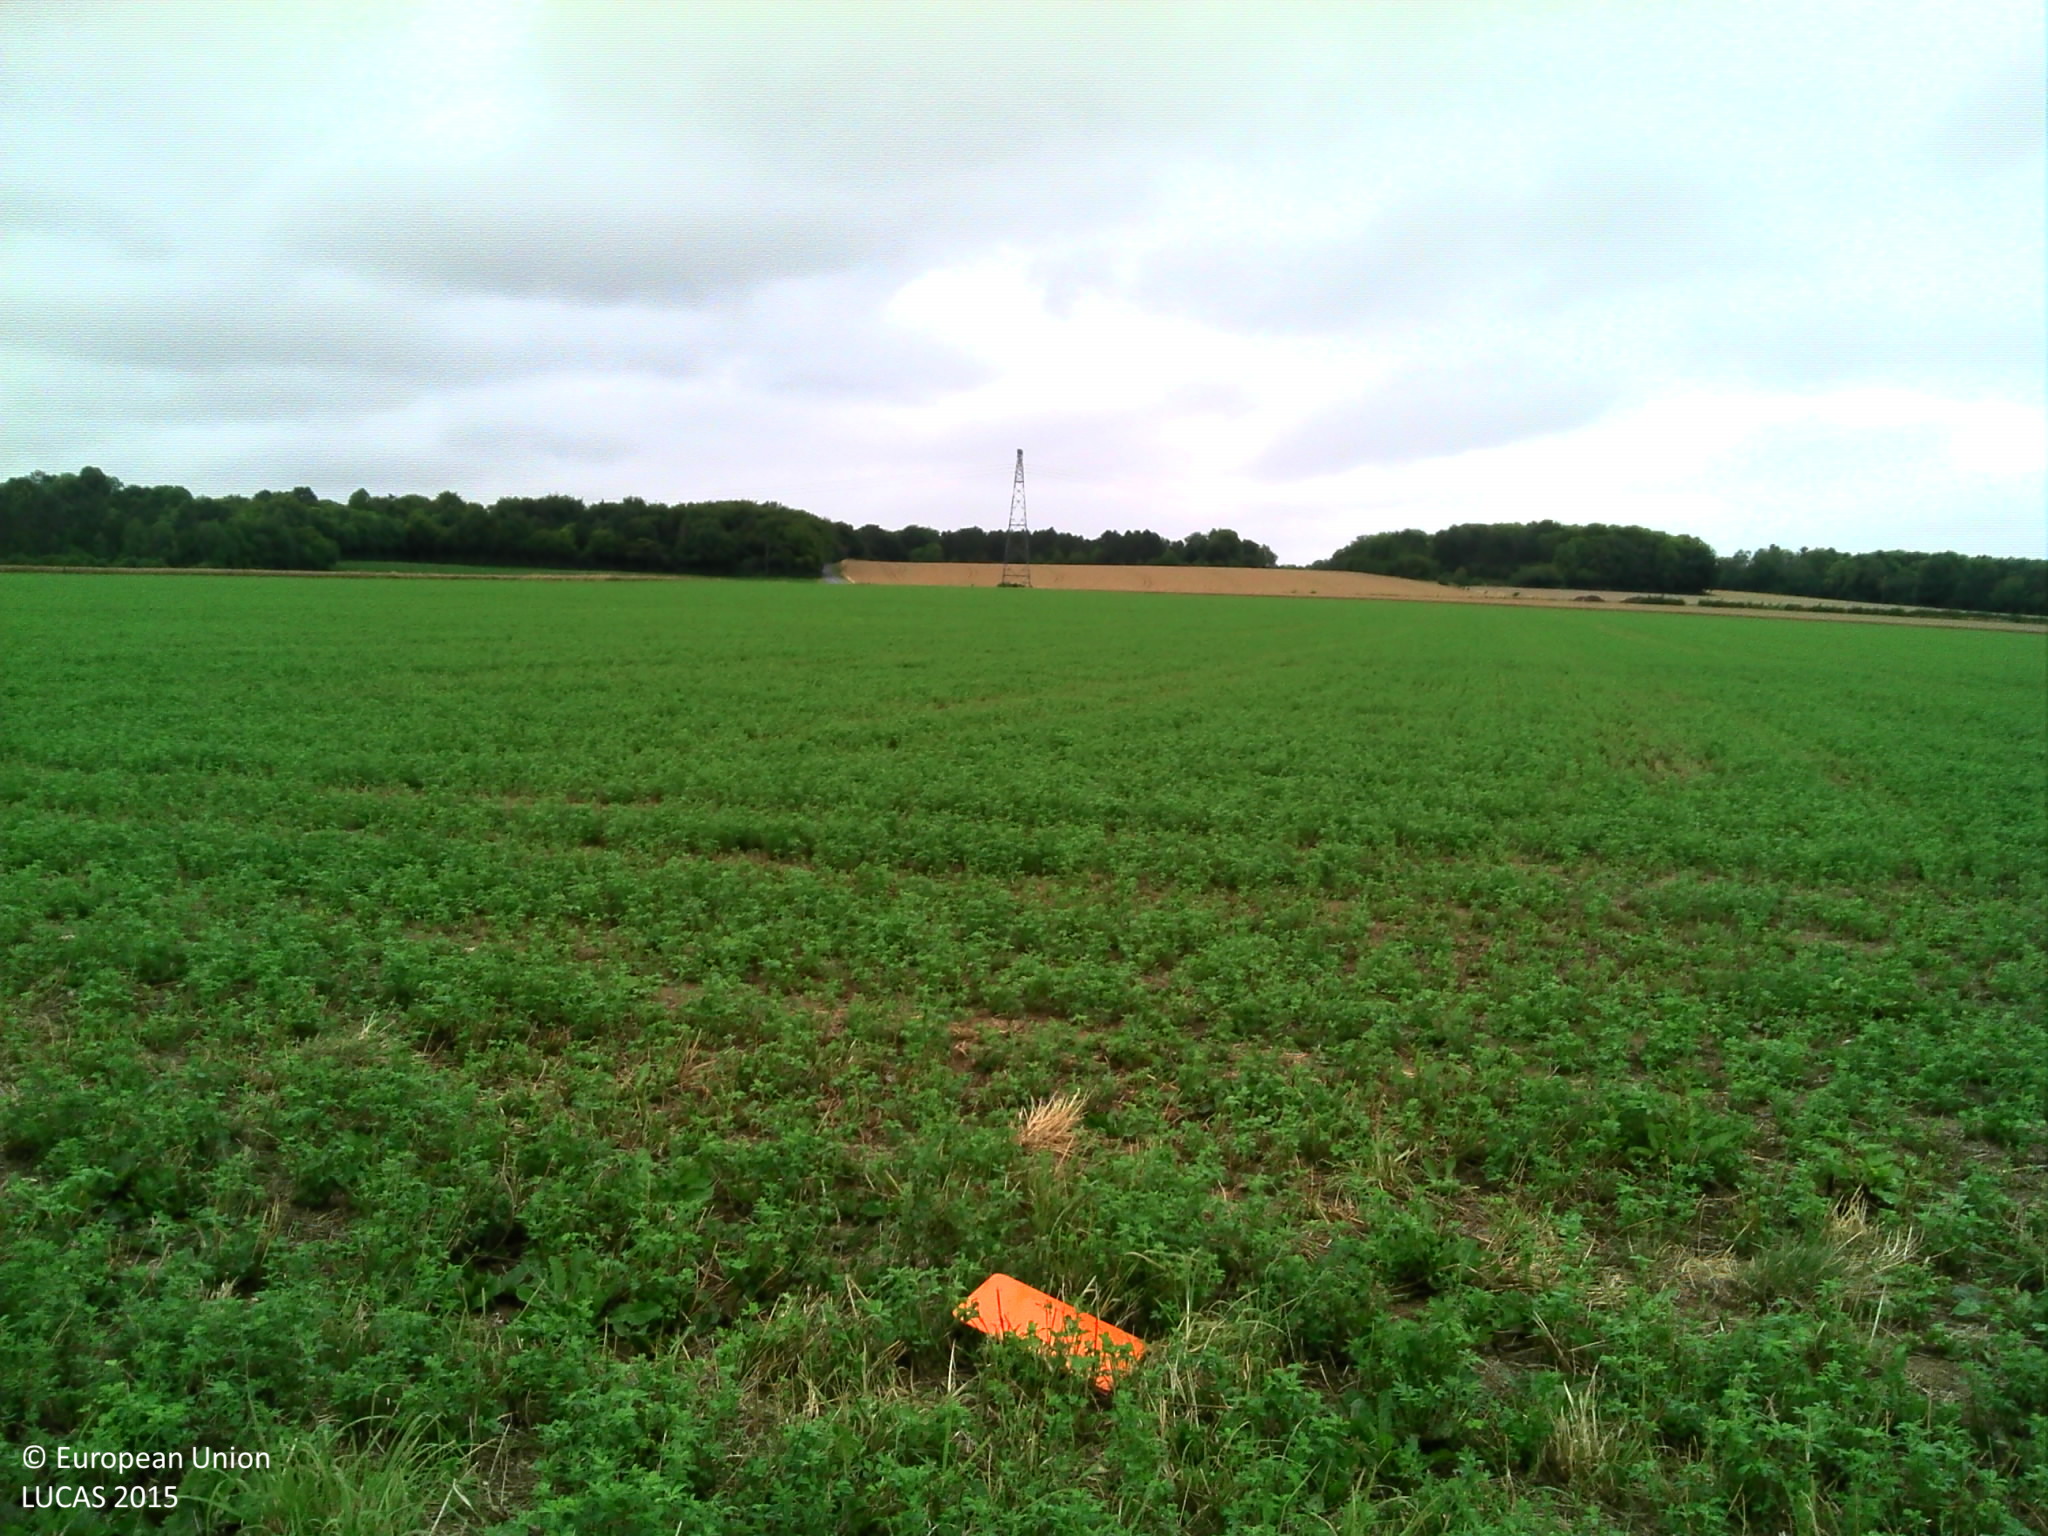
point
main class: Cropland
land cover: Lucerne
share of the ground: > 75 %
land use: Agriculture (excluding fallow land and kitchen gardens)
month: July
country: FR
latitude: 49.9685
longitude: 2.1642
